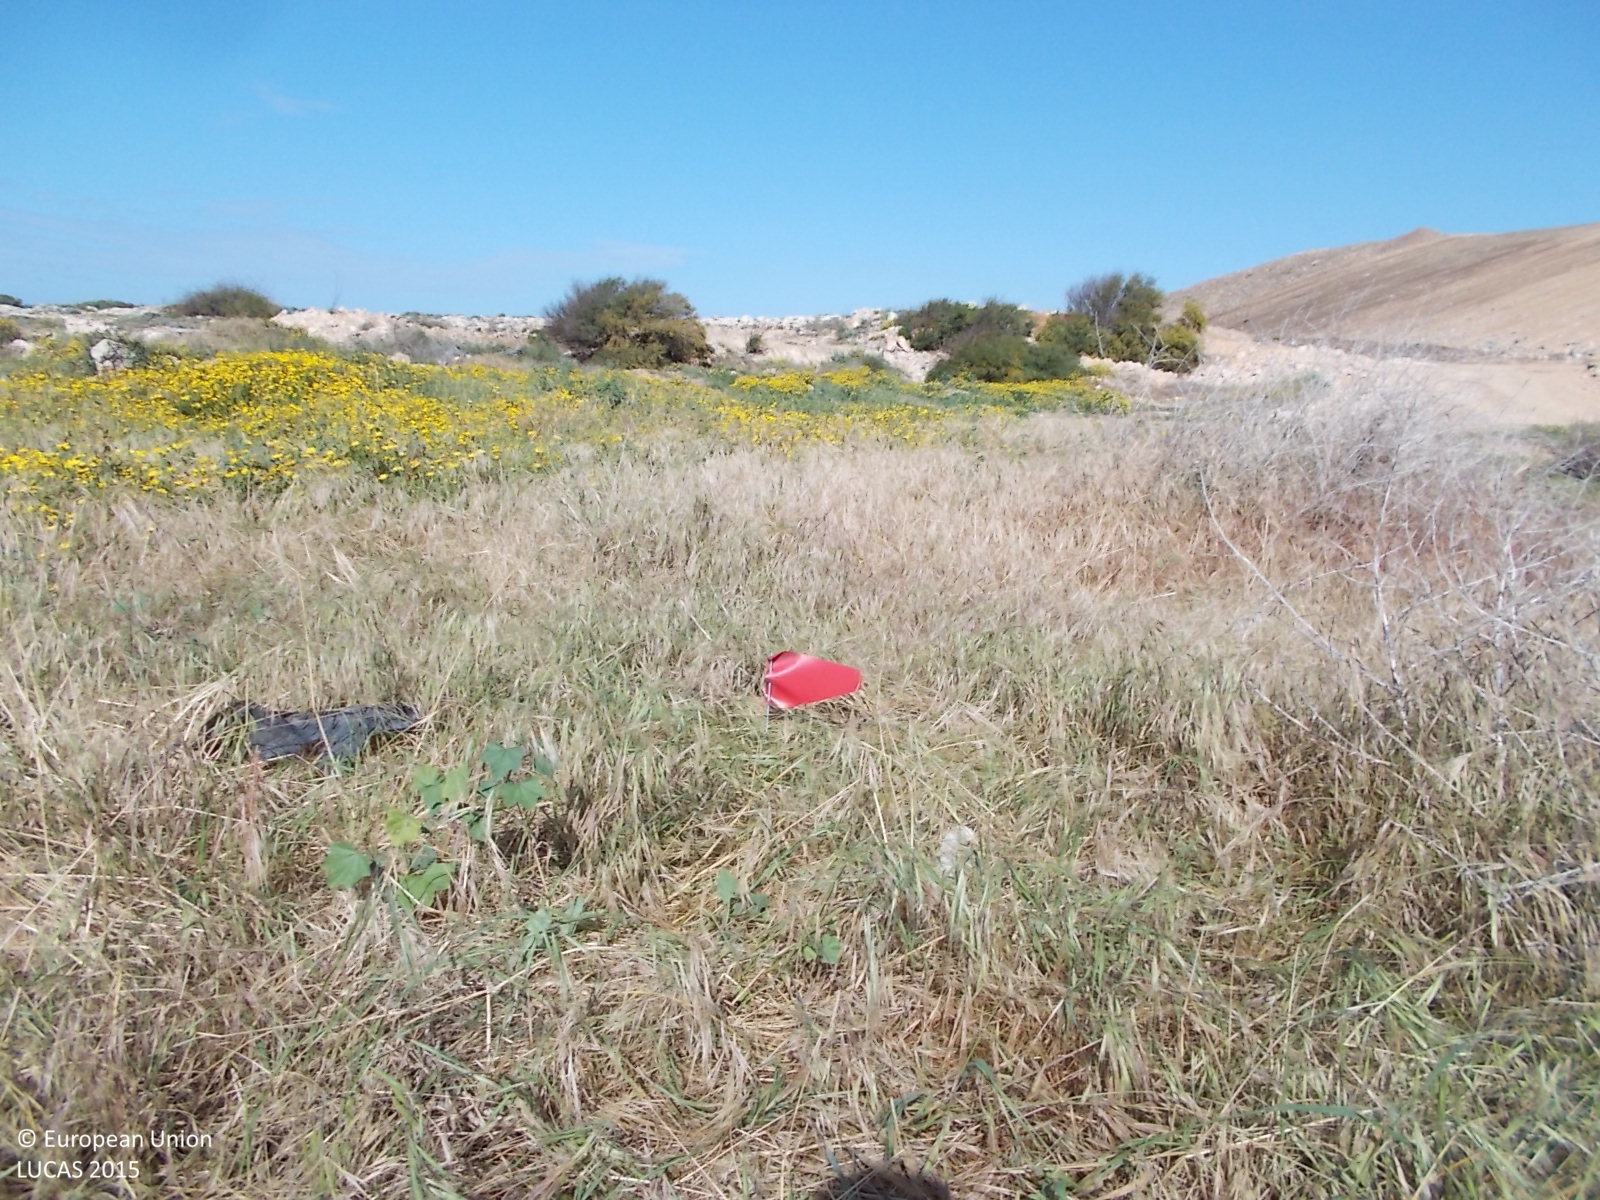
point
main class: Grassland
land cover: Grassland without tree/shrub cover
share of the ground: > 75 %
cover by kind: herbaceous plants 100 %
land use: Semi-natural and natural areas not in use
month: March
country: CY
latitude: 34.9673
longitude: 34.0600
